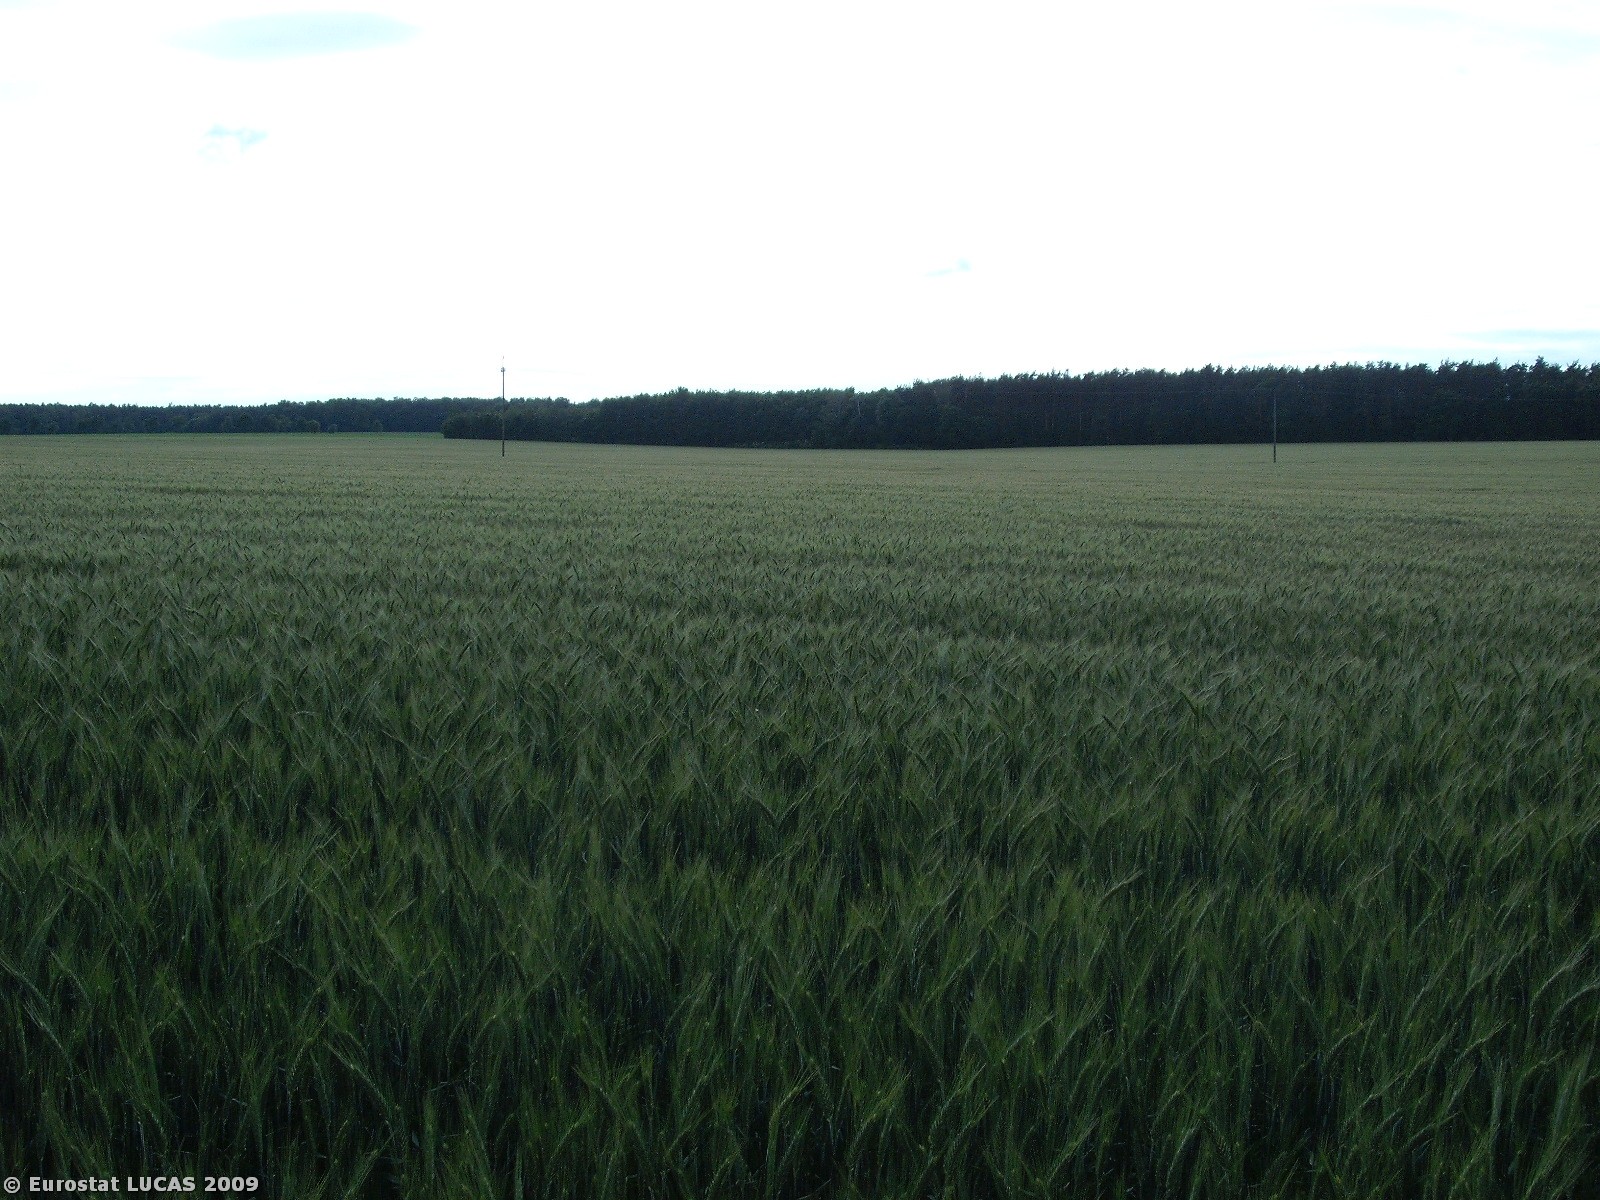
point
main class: Cropland
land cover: Barley
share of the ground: > 75 %
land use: Agriculture (excluding fallow land and kitchen gardens)
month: June
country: PL
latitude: 51.3124
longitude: 20.2938
